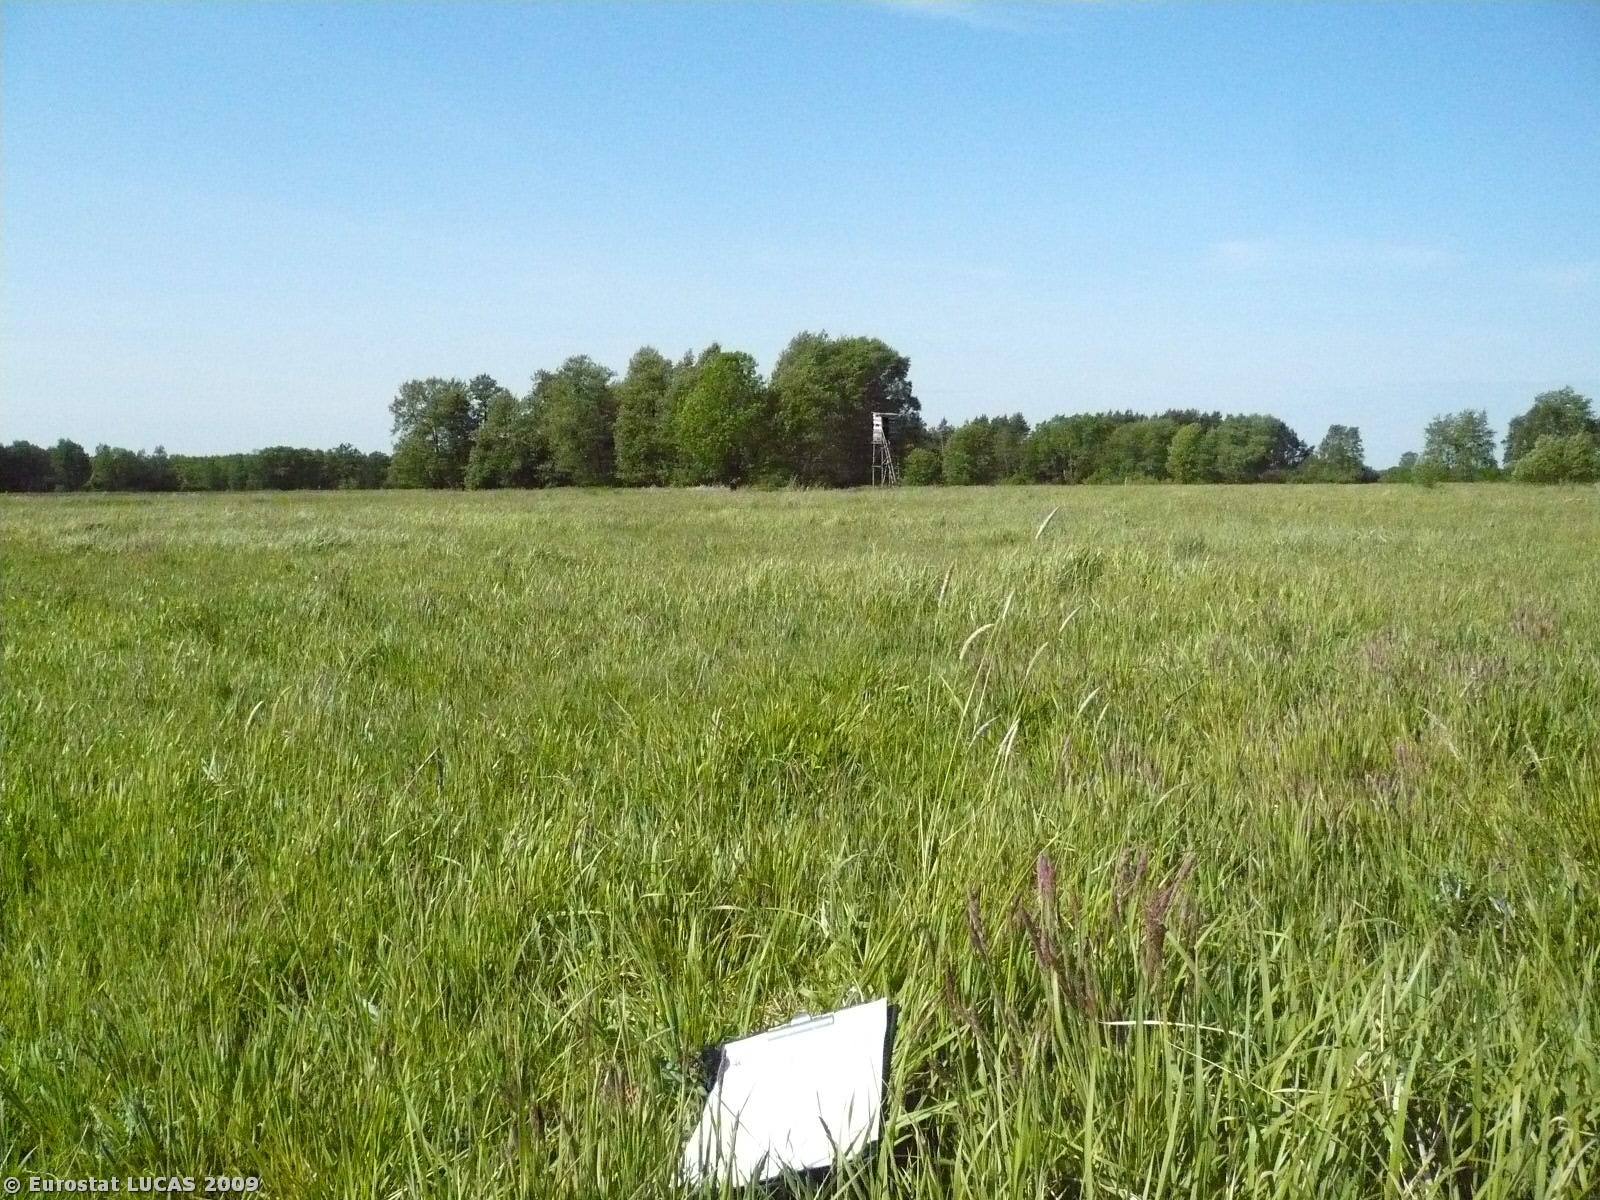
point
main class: Grassland
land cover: Grassland without tree/shrub cover
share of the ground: > 75 %
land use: Agriculture (excluding fallow land and kitchen gardens)
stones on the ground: < 10 %
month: May
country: PL
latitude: 51.8465
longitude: 15.6514
